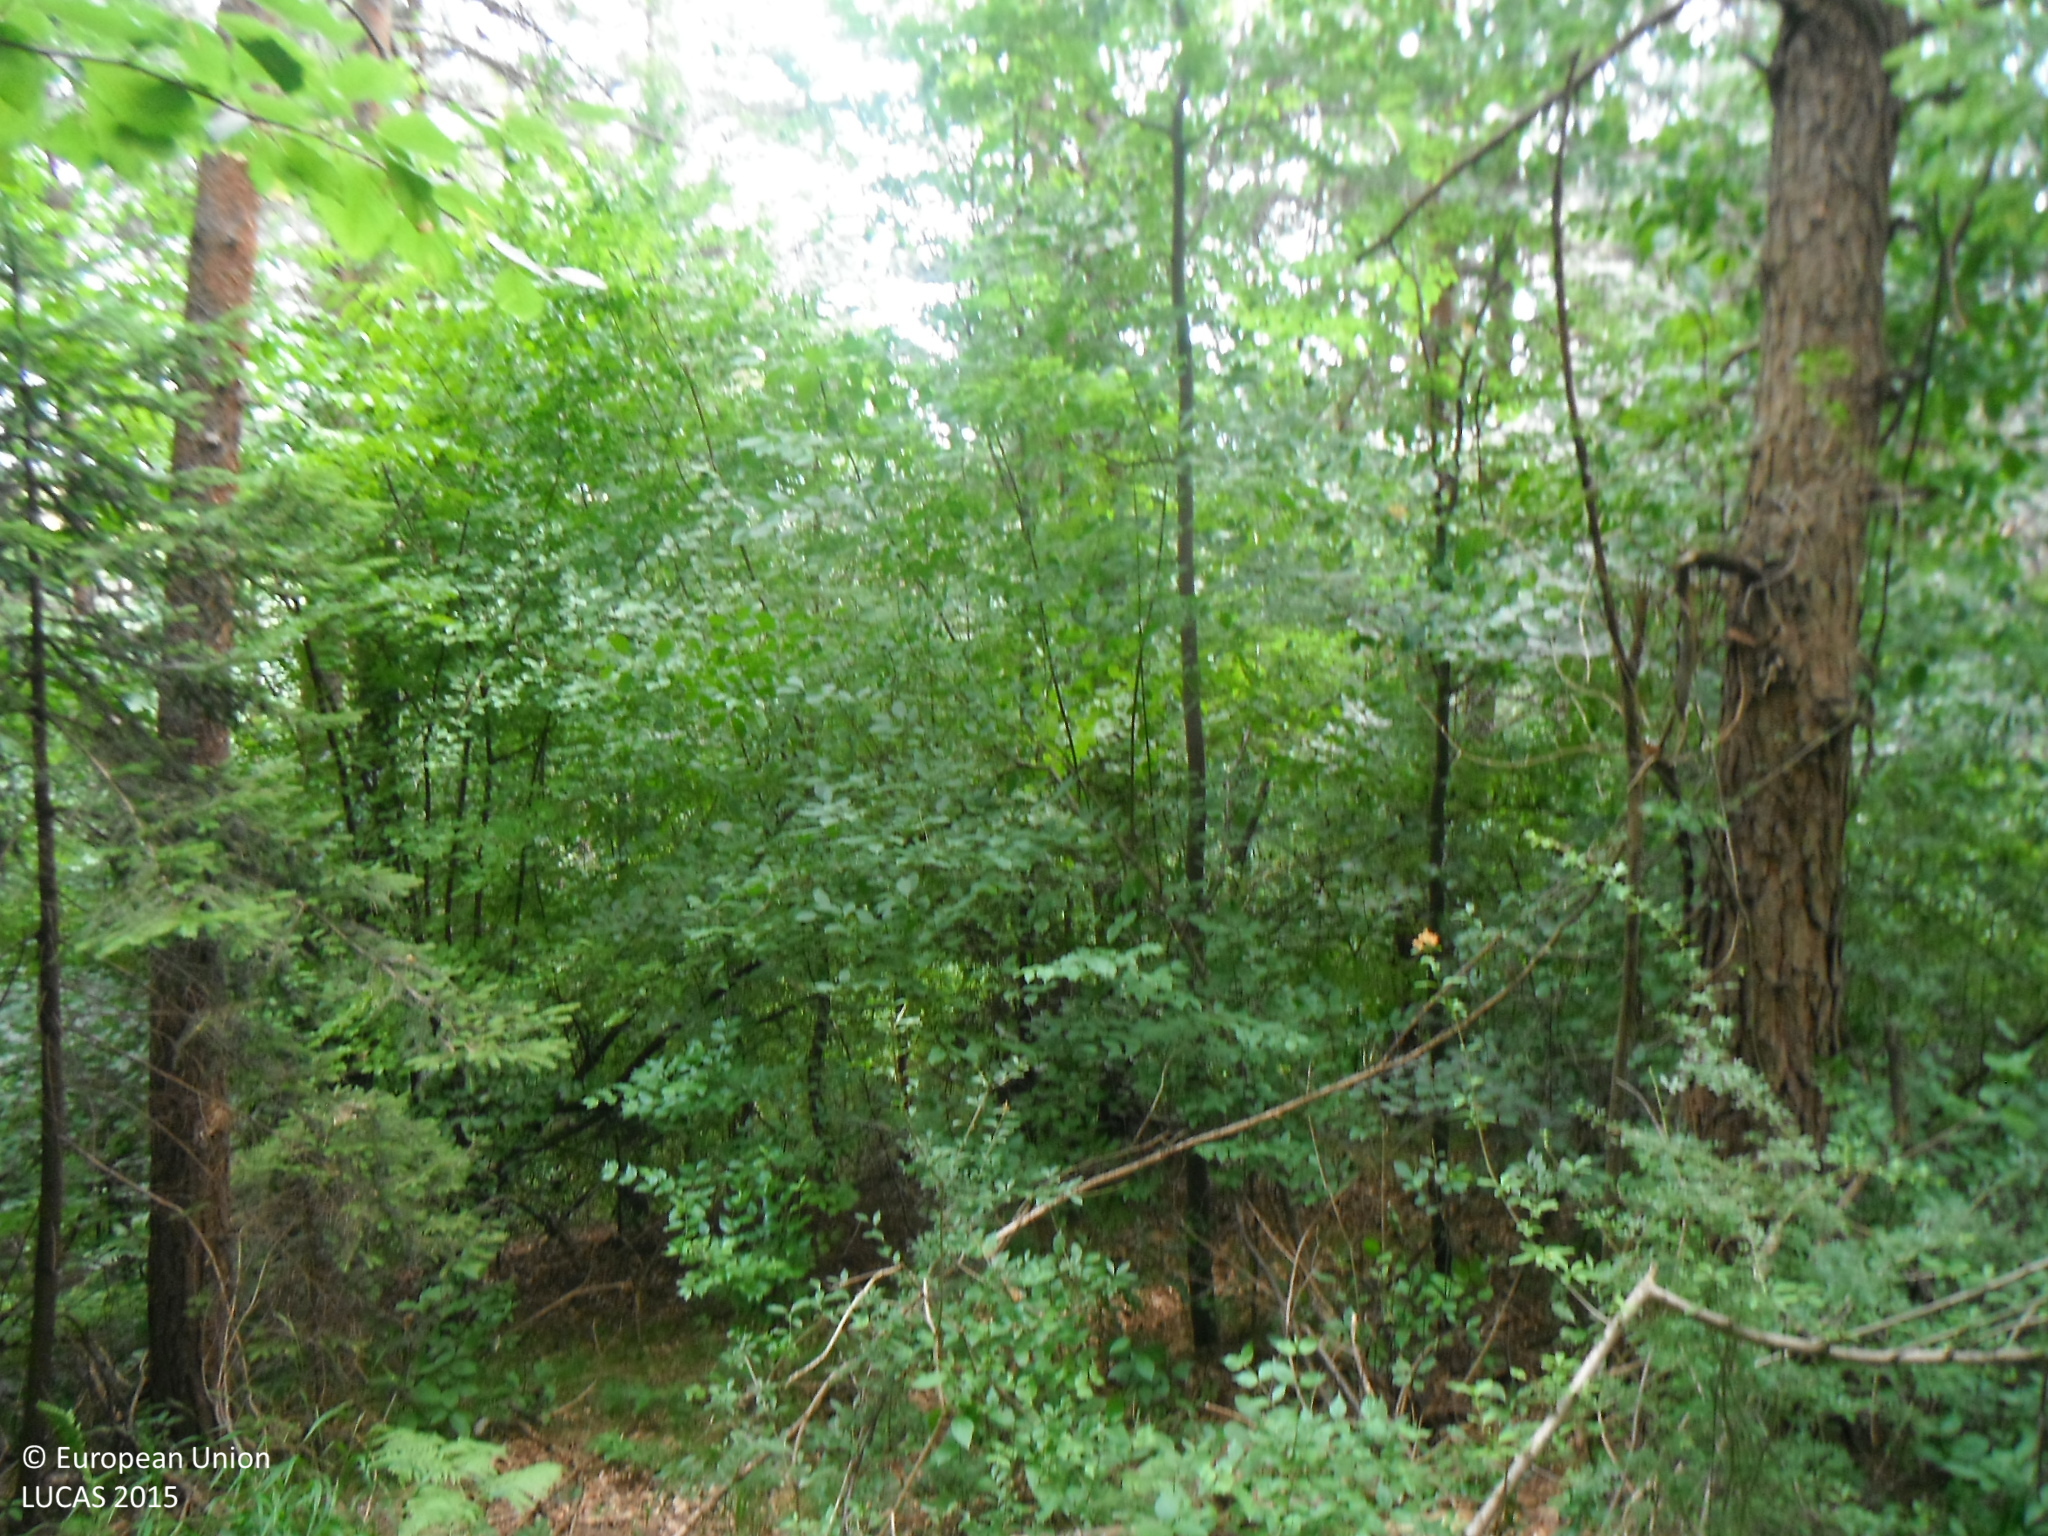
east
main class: Woodland
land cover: Pine dominated coniferous woodland
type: alpine coniferous forest
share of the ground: > 75 %
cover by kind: coniferous forest trees 80 %, herbaceous plants 10 %, shrubs 5 %, unconsolidated bare surface 5 %
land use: Forestry
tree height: > 5 m
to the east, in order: Pine dominated coniferous woodland; Tracks; Pine dominated coniferous woodland; Spruce dominated coniferous woodland; Tracks; Pine dominated coniferous woodland
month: July
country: SK
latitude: 49.0672
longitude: 18.5454
